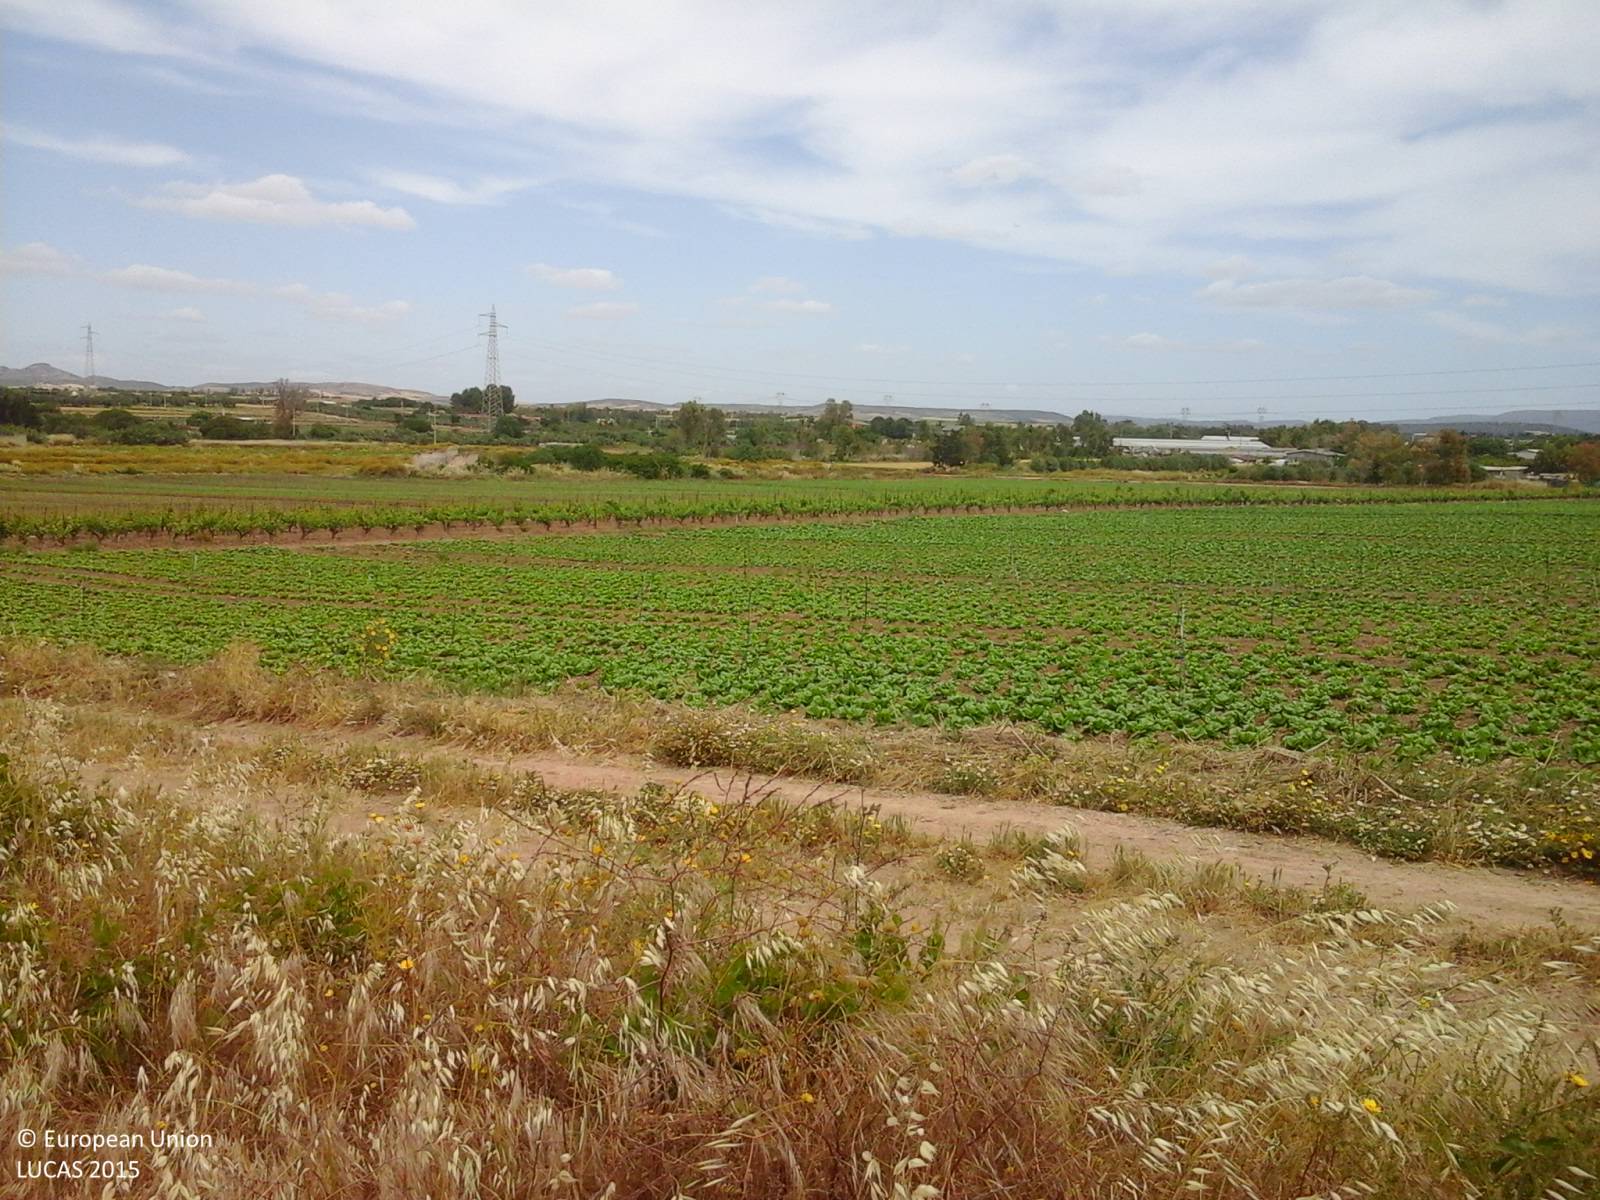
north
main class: Grassland
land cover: Spontaneously vegetated surfaces
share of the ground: > 75 %
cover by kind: herbaceous plants 100 %
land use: Fallow land
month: May
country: IT
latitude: 39.3034
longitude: 9.1125
